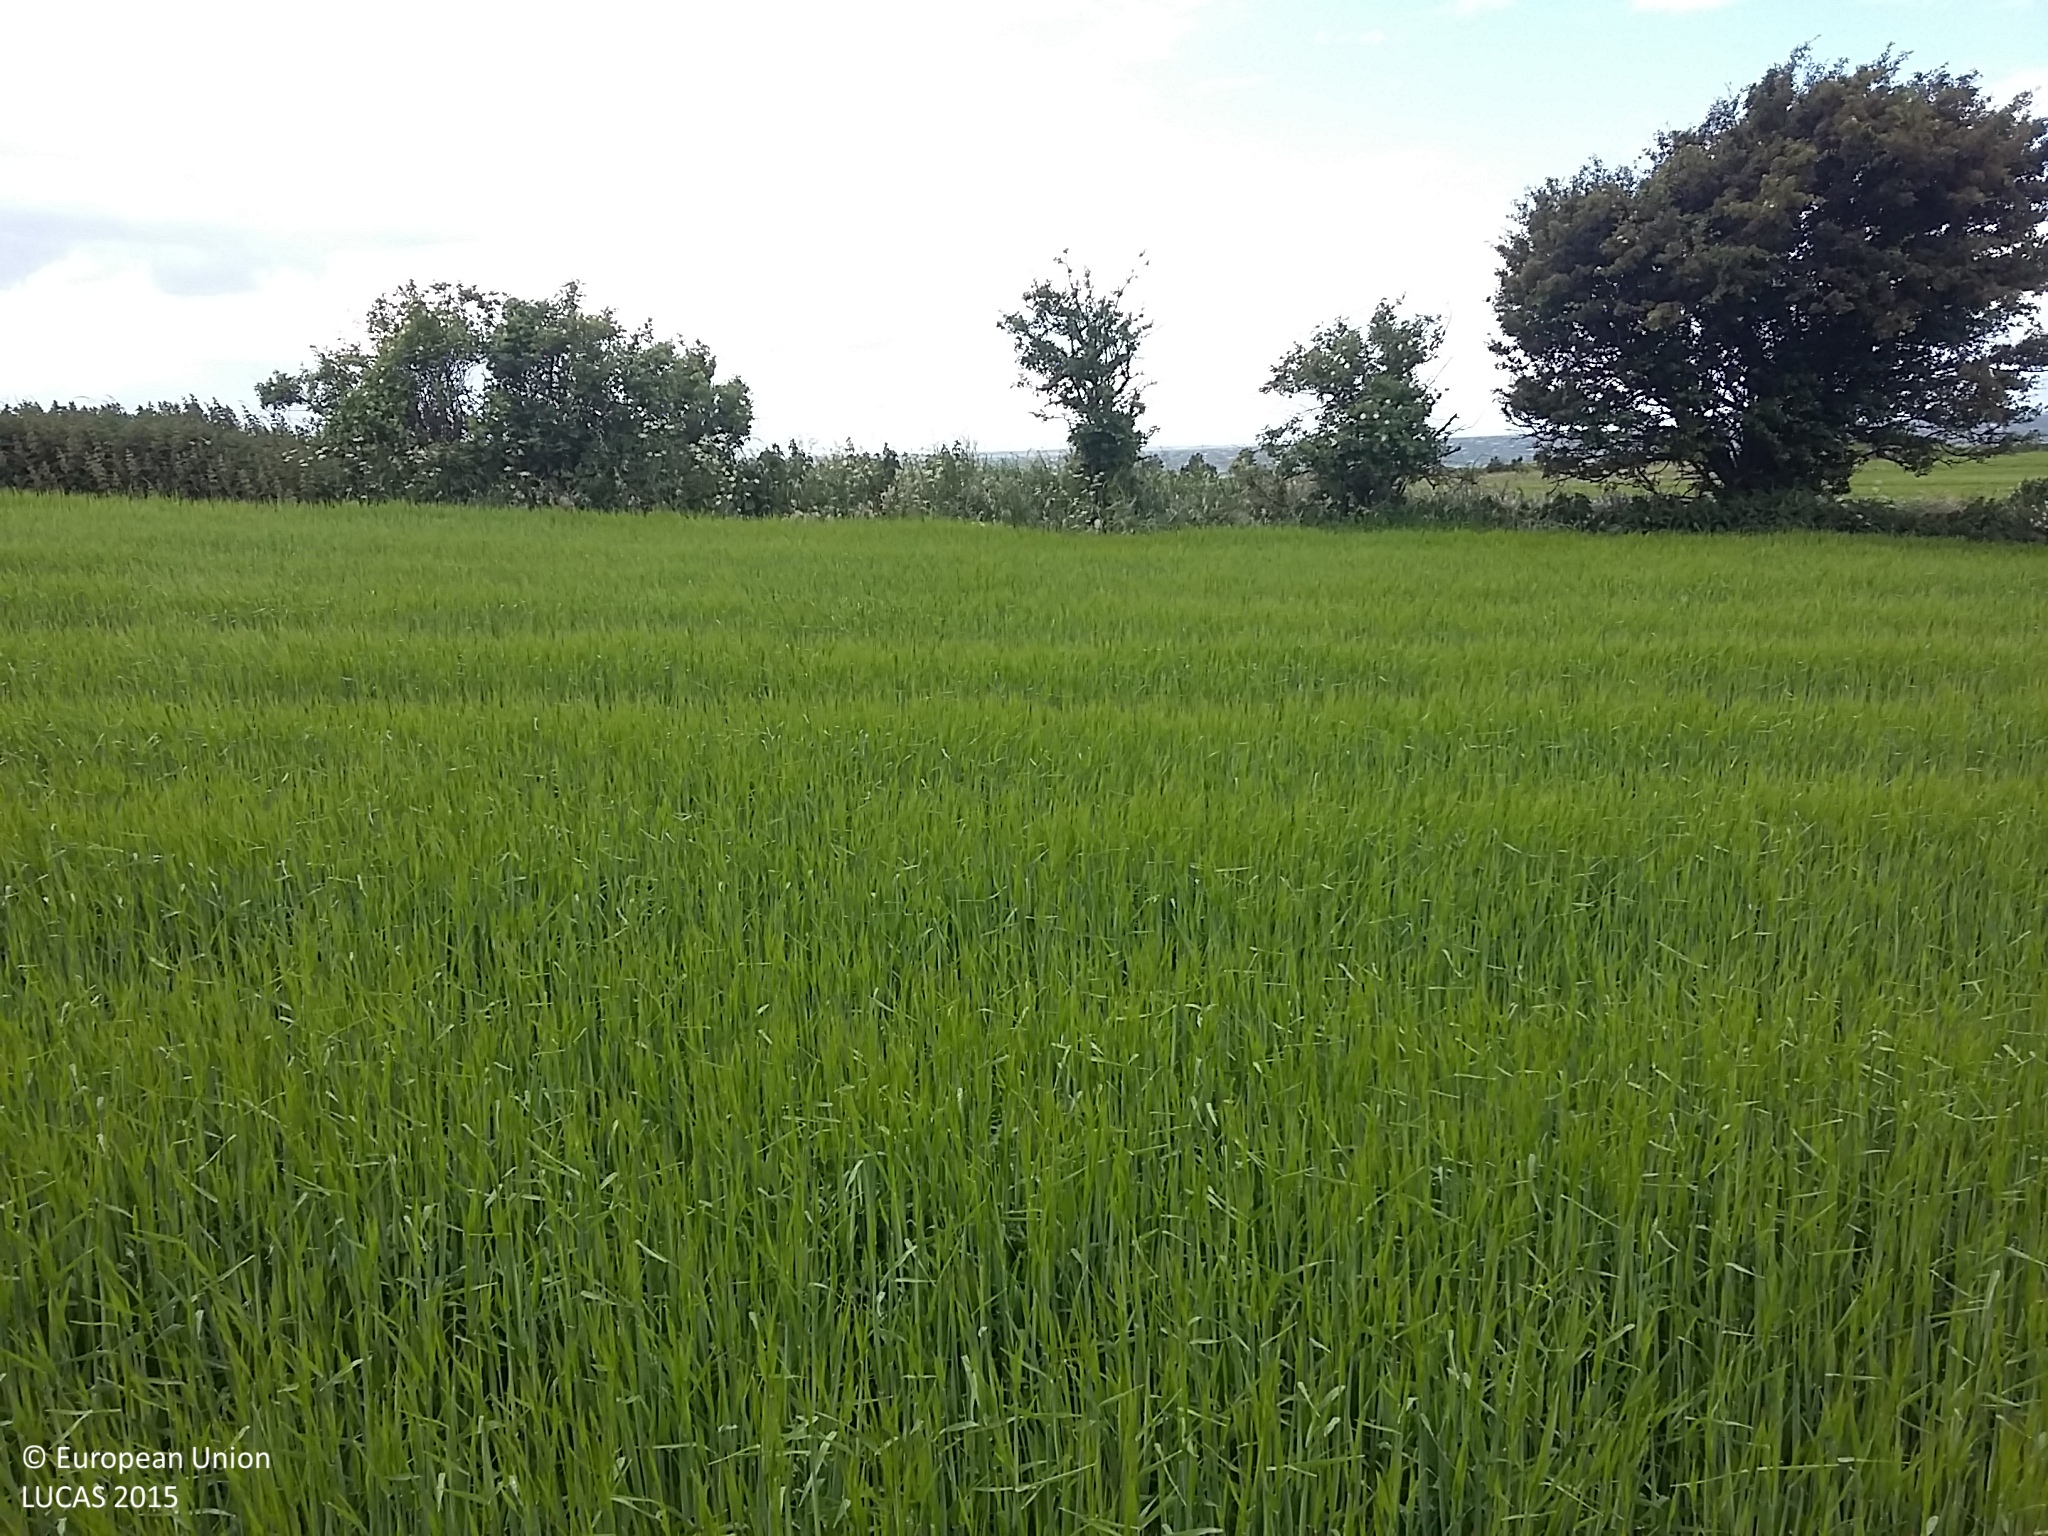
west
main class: Cropland
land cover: Barley
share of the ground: > 75 %
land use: Agriculture (excluding fallow land and kitchen gardens)
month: June
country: DK
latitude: 54.8559
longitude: 10.6693
